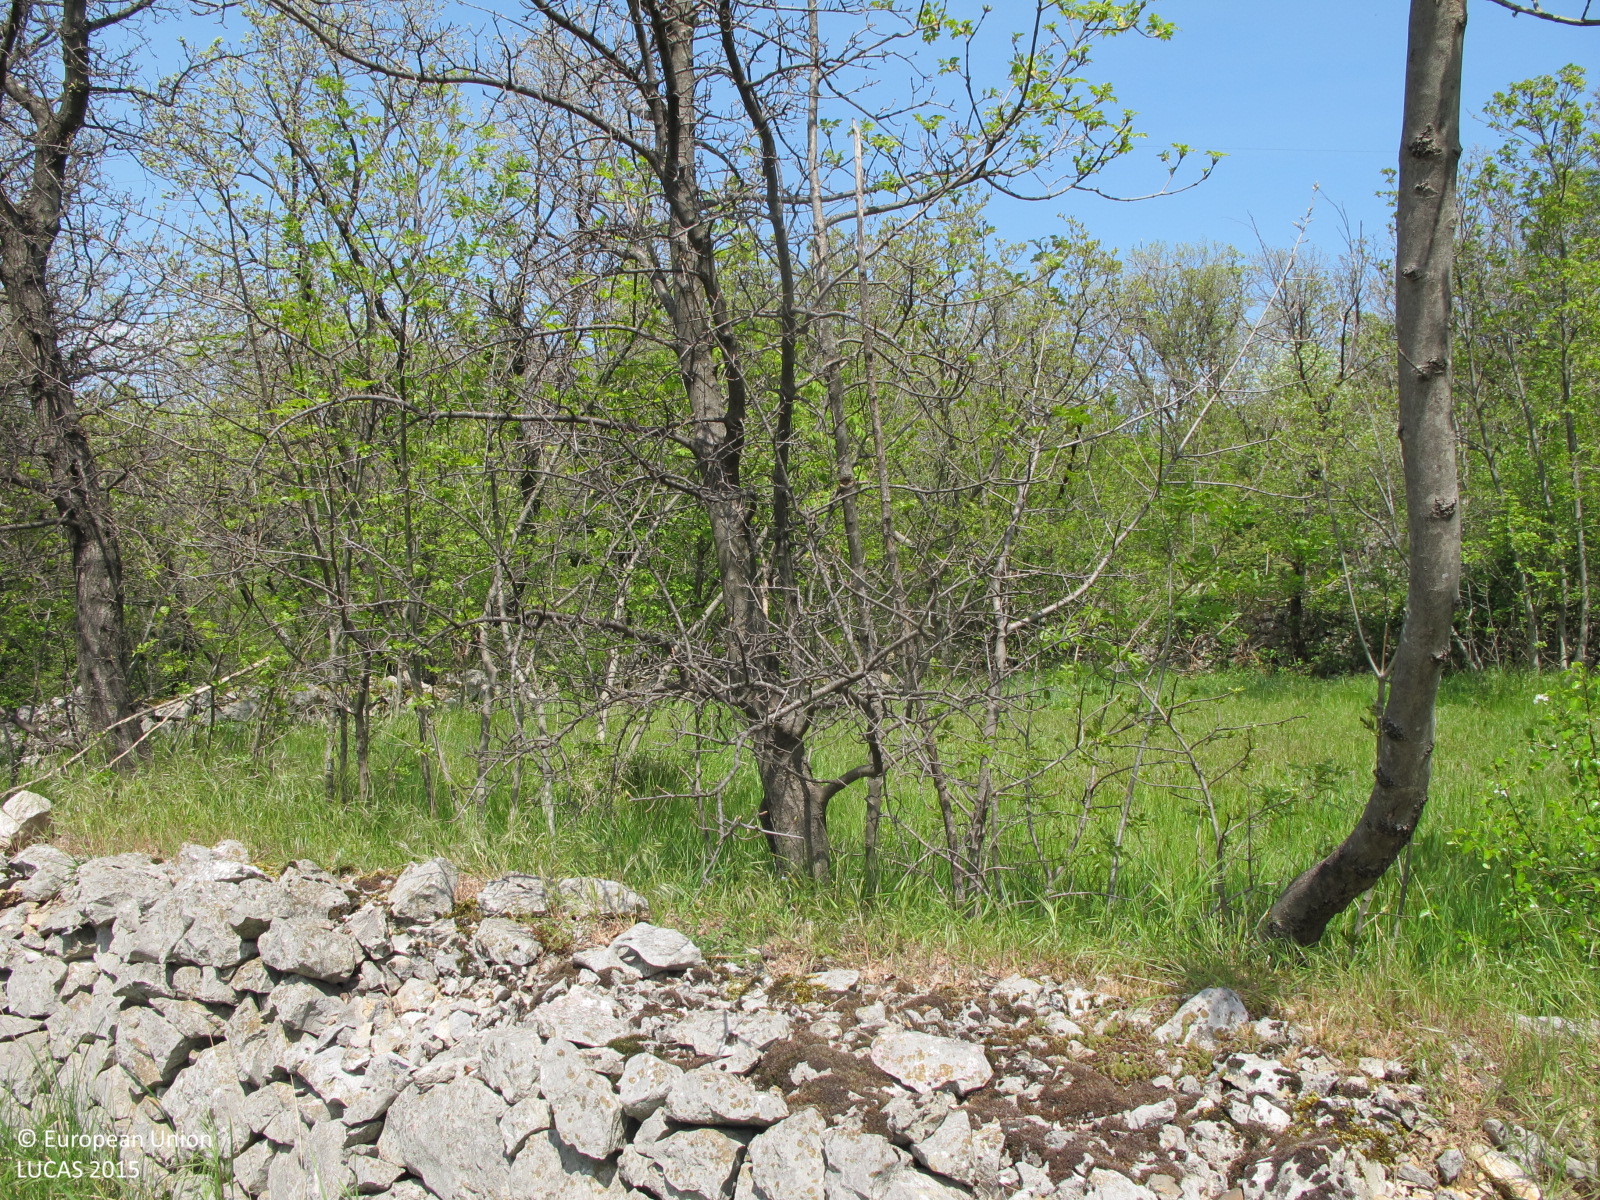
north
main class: Grassland
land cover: Grassland with sparse tree/shrub cover
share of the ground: > 75 %
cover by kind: herbaceous plants 70 %, shrubs 10 %, broadleaved forest trees 5 %
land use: Abandoned areas
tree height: < 5 m
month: April
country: HR
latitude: 45.3162
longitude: 14.5489
